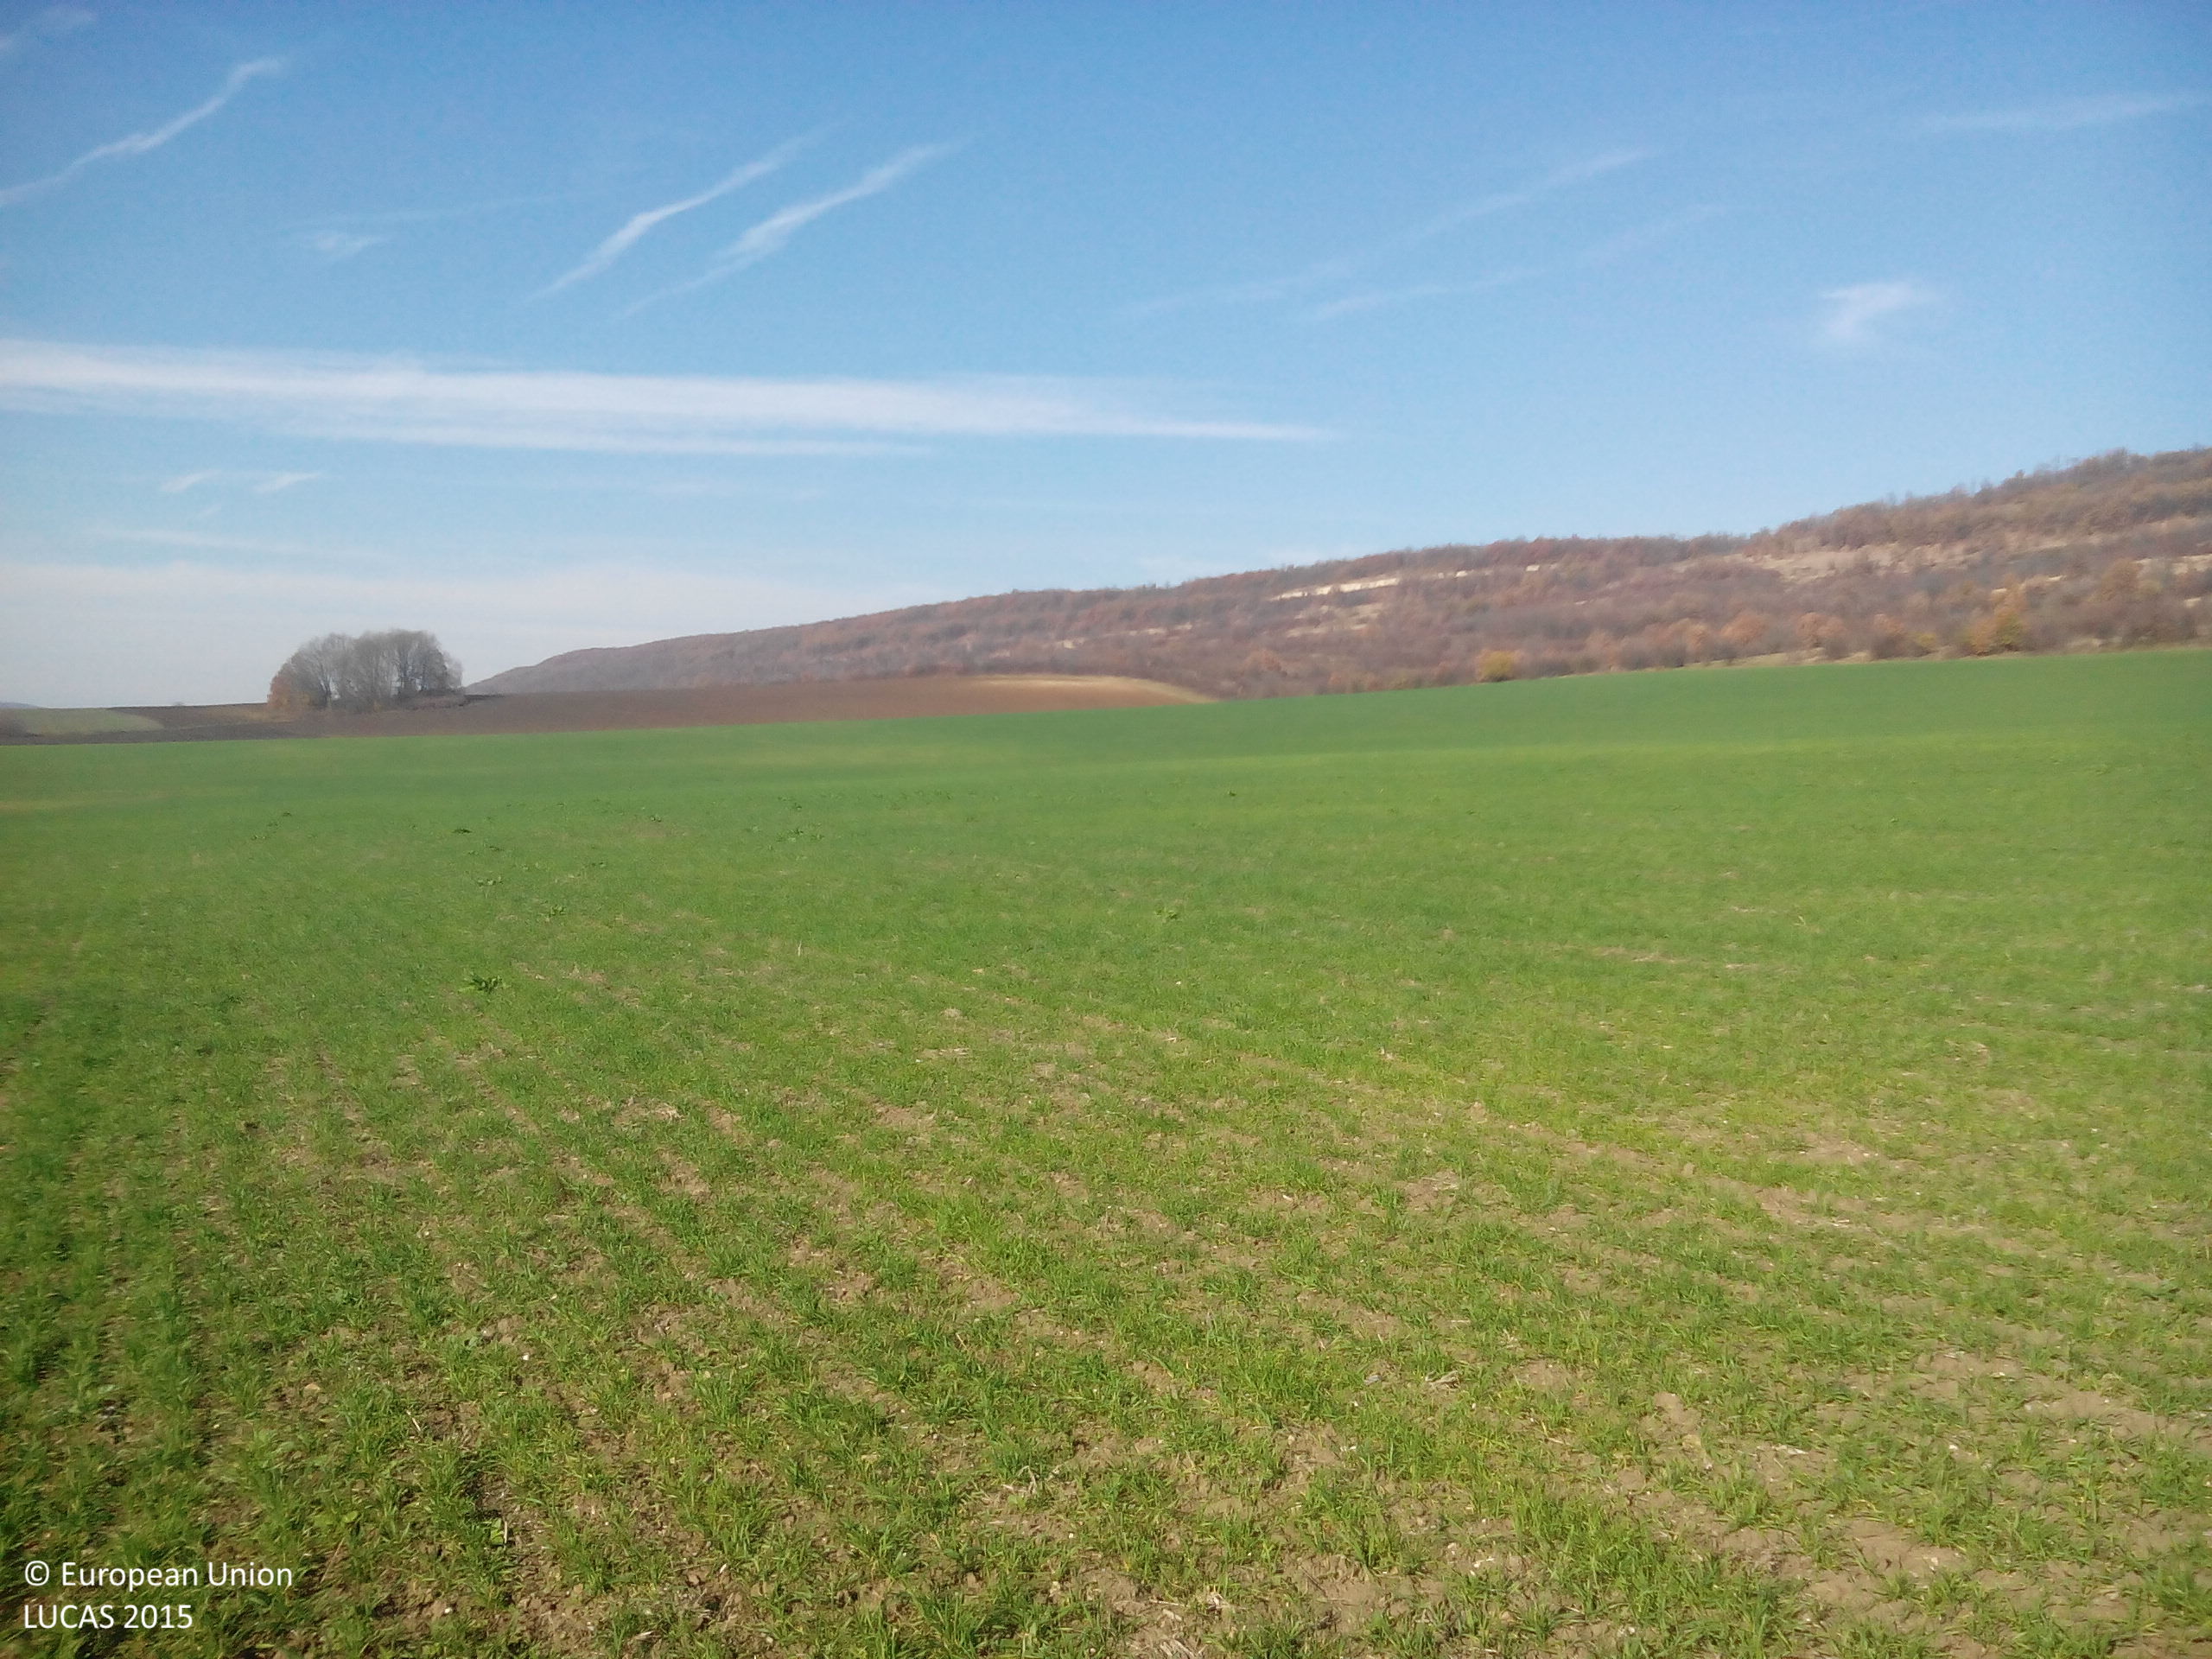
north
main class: Cropland
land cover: Common wheat
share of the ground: 50 - 75 %
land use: Agriculture (excluding fallow land and kitchen gardens)
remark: Harvested field
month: November
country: BG
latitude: 43.3111
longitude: 23.8195
